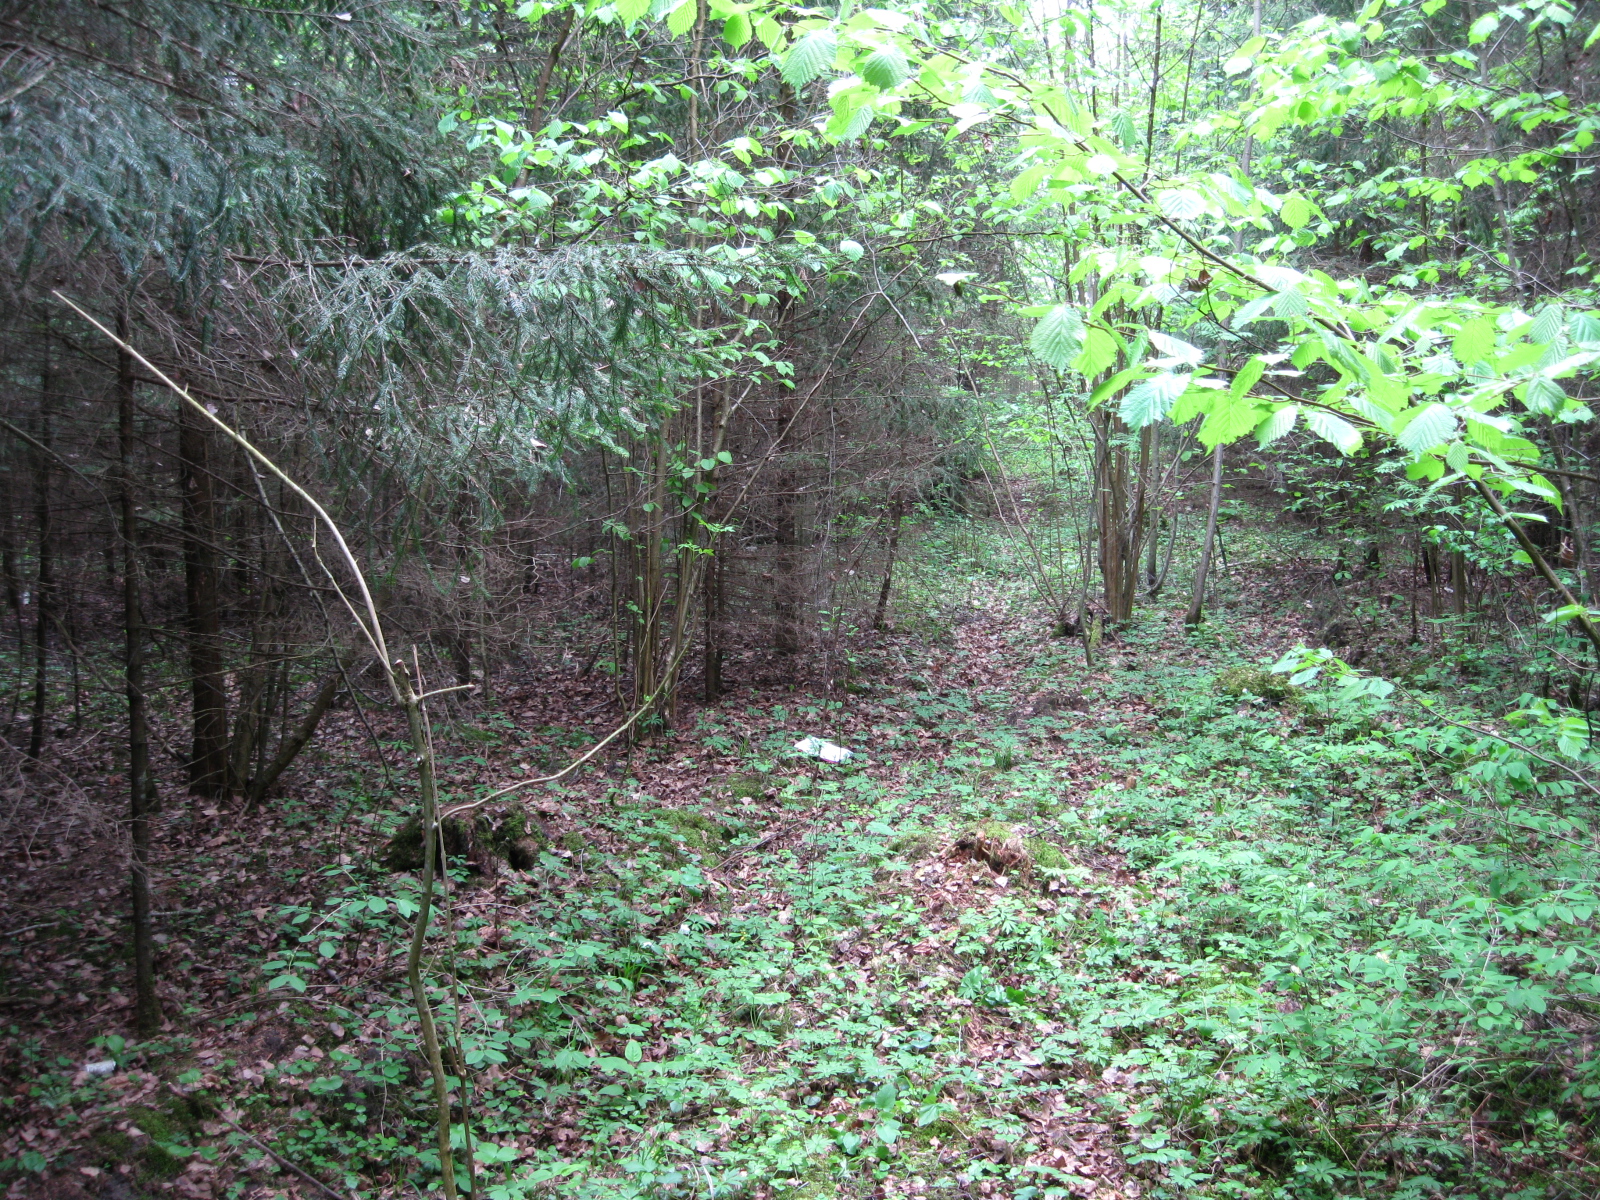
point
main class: Woodland
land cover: Spruce dominated mixed woodland
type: hemiboreal forest and nemoral coniferous forest and mixed broadleaved-coniferous forest
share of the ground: > 75 %
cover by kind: coniferous forest trees 50 %, broadleaved forest trees 40 %, shrubs 5 %, herbaceous plants 5 %
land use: Forestry
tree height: > 5 m
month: May
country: LT
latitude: 56.1330
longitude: 23.4465
